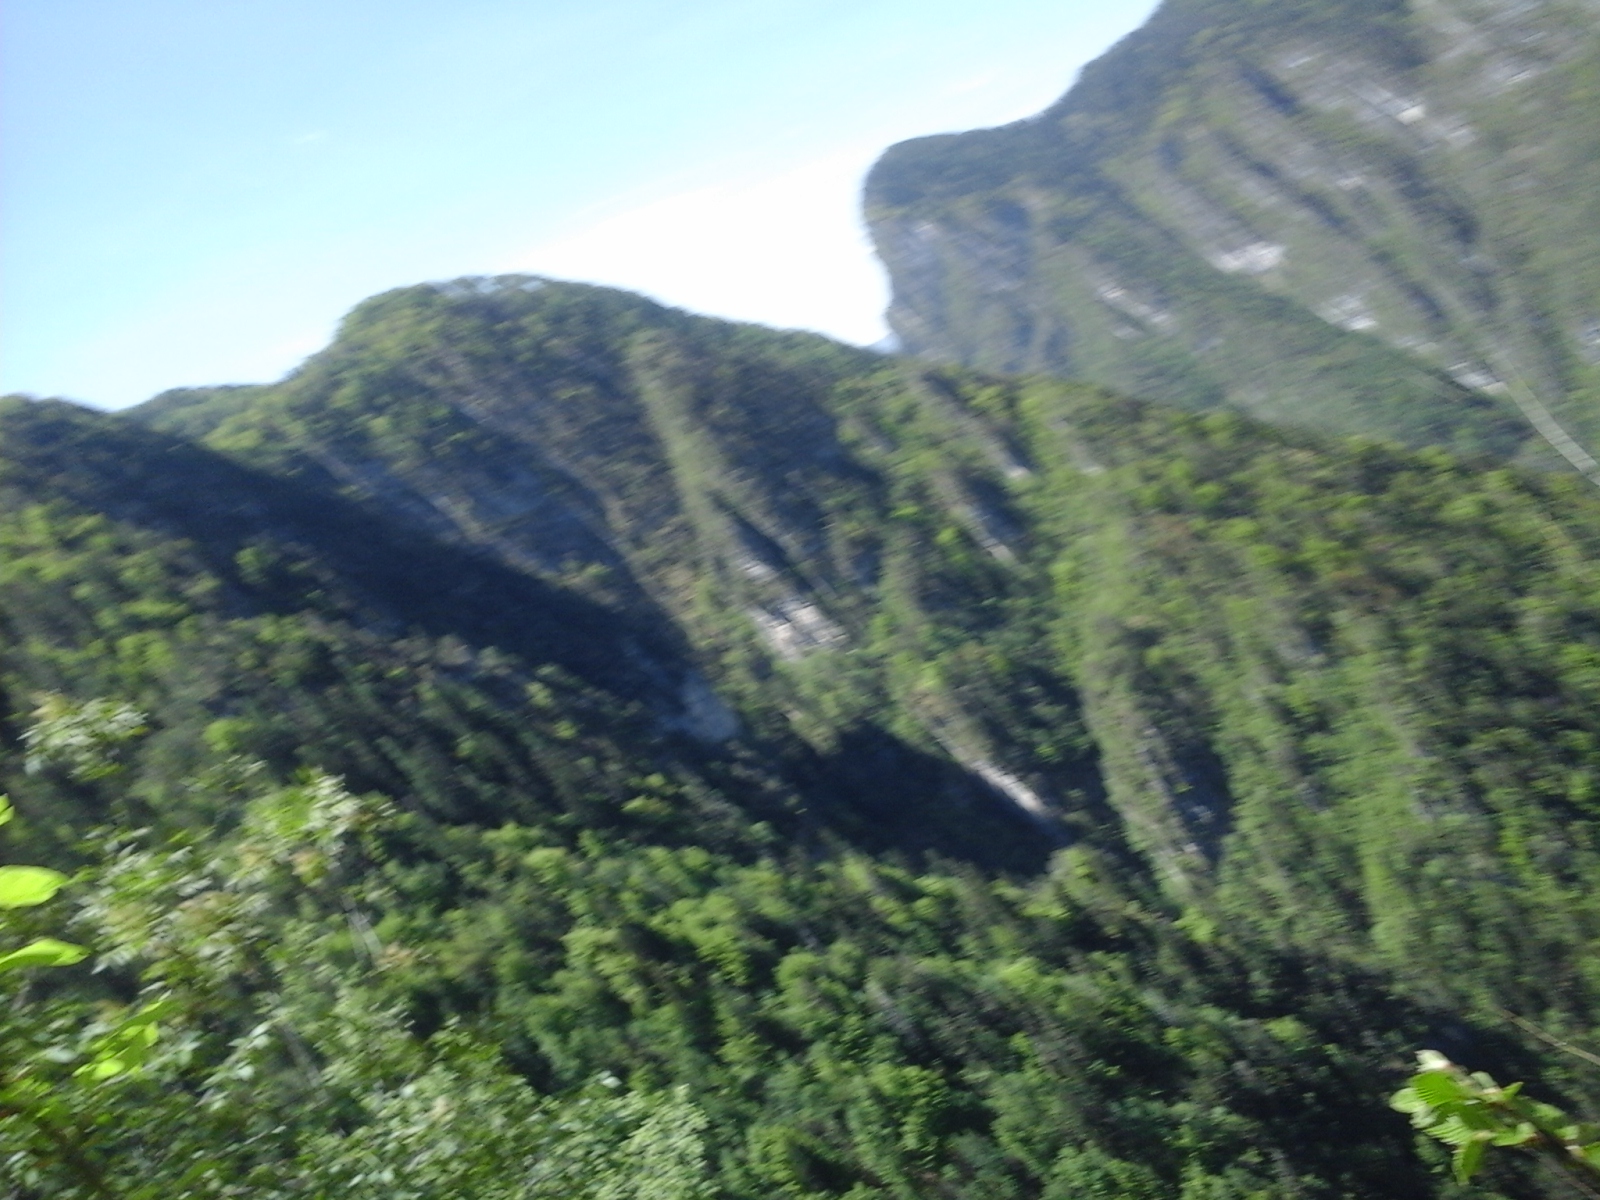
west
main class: Woodland
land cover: Other mixed woodland
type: alpine coniferous forest
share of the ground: > 75 %
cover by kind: shrubs 50 %, herbaceous plants 15 %, unconsolidated bare surface 15 %, coniferous forest trees 10 %, broadleaved forest trees 10 %
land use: Forestry
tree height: > 5 m
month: May
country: IT
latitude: 45.8628
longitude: 10.6559
